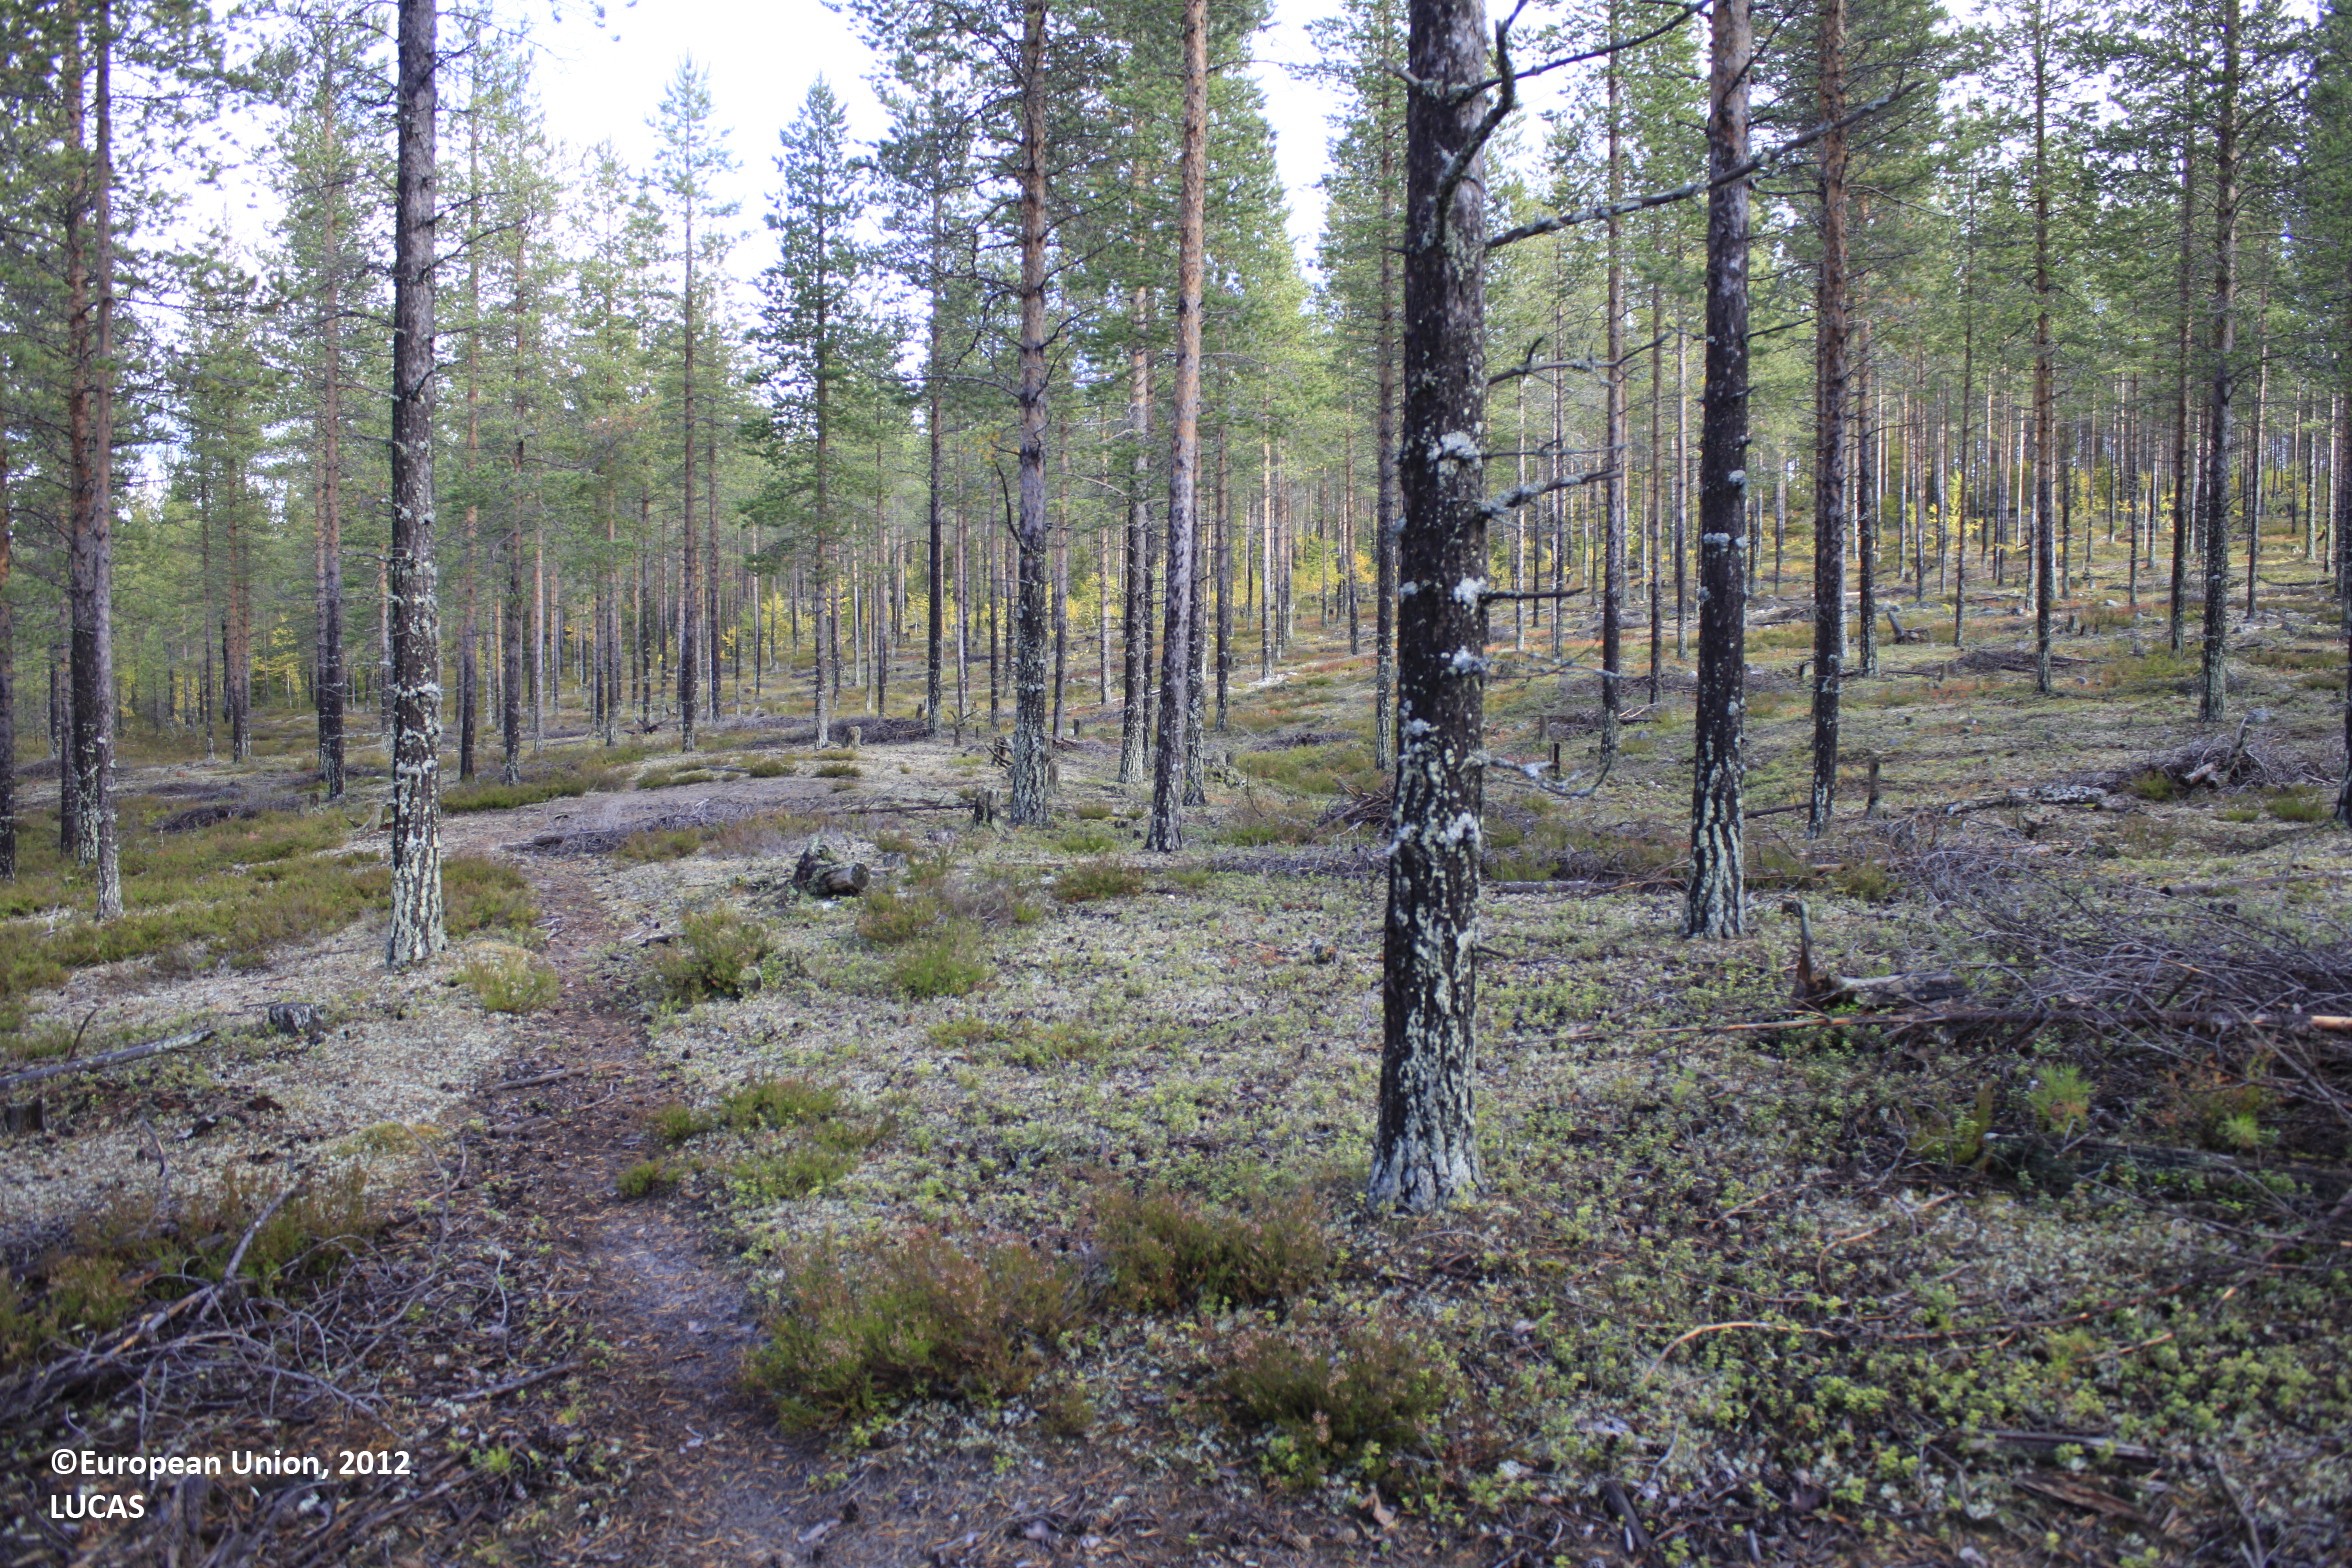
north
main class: Woodland
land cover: Pine dominated coniferous woodland
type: boreal forest
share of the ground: 25 - 50 %
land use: Forestry
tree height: > 5 m
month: September
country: FI
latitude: 65.5710
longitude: 27.3516
